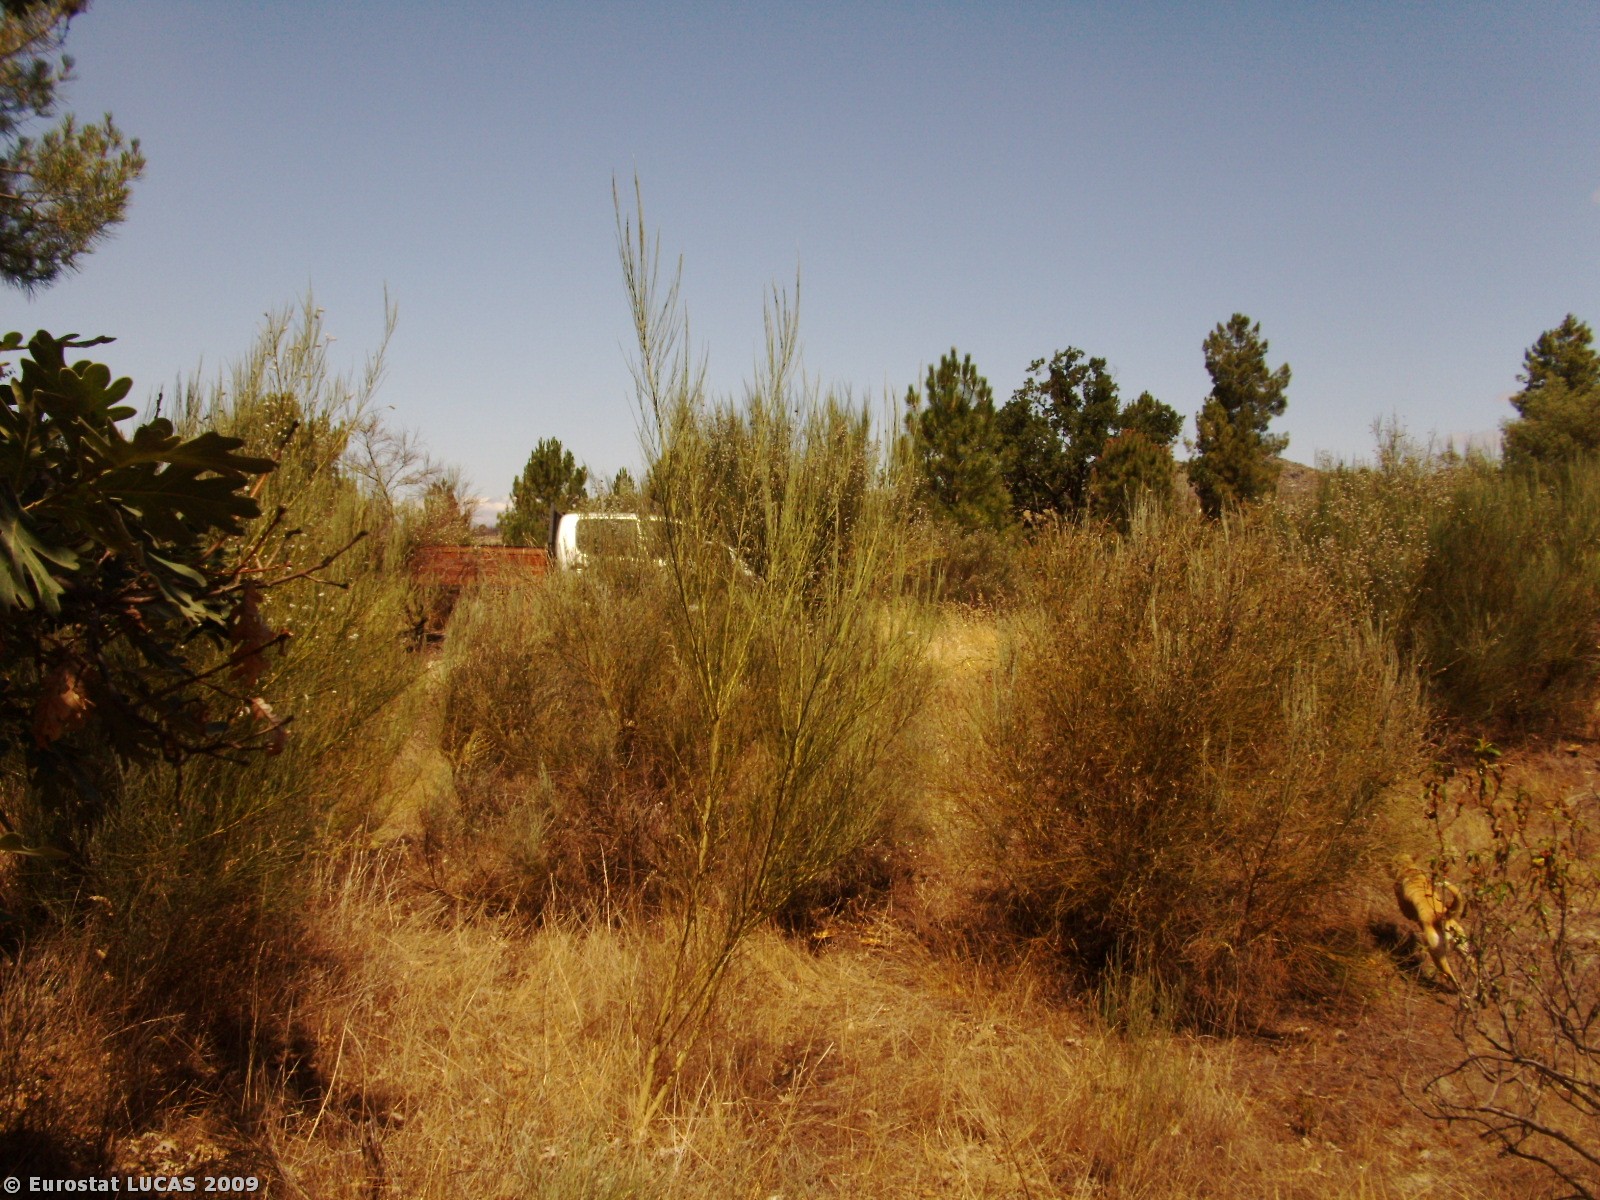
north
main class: Woodland
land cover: Coniferous woodland
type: coniferous forest of the mediterranean region
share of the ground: 50 - 75 %
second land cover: Shrubland with sparse tree cover
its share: < 10 %
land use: Forestry
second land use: Unused
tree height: > 5 m
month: July
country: PT
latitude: 40.3000
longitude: -7.2186
